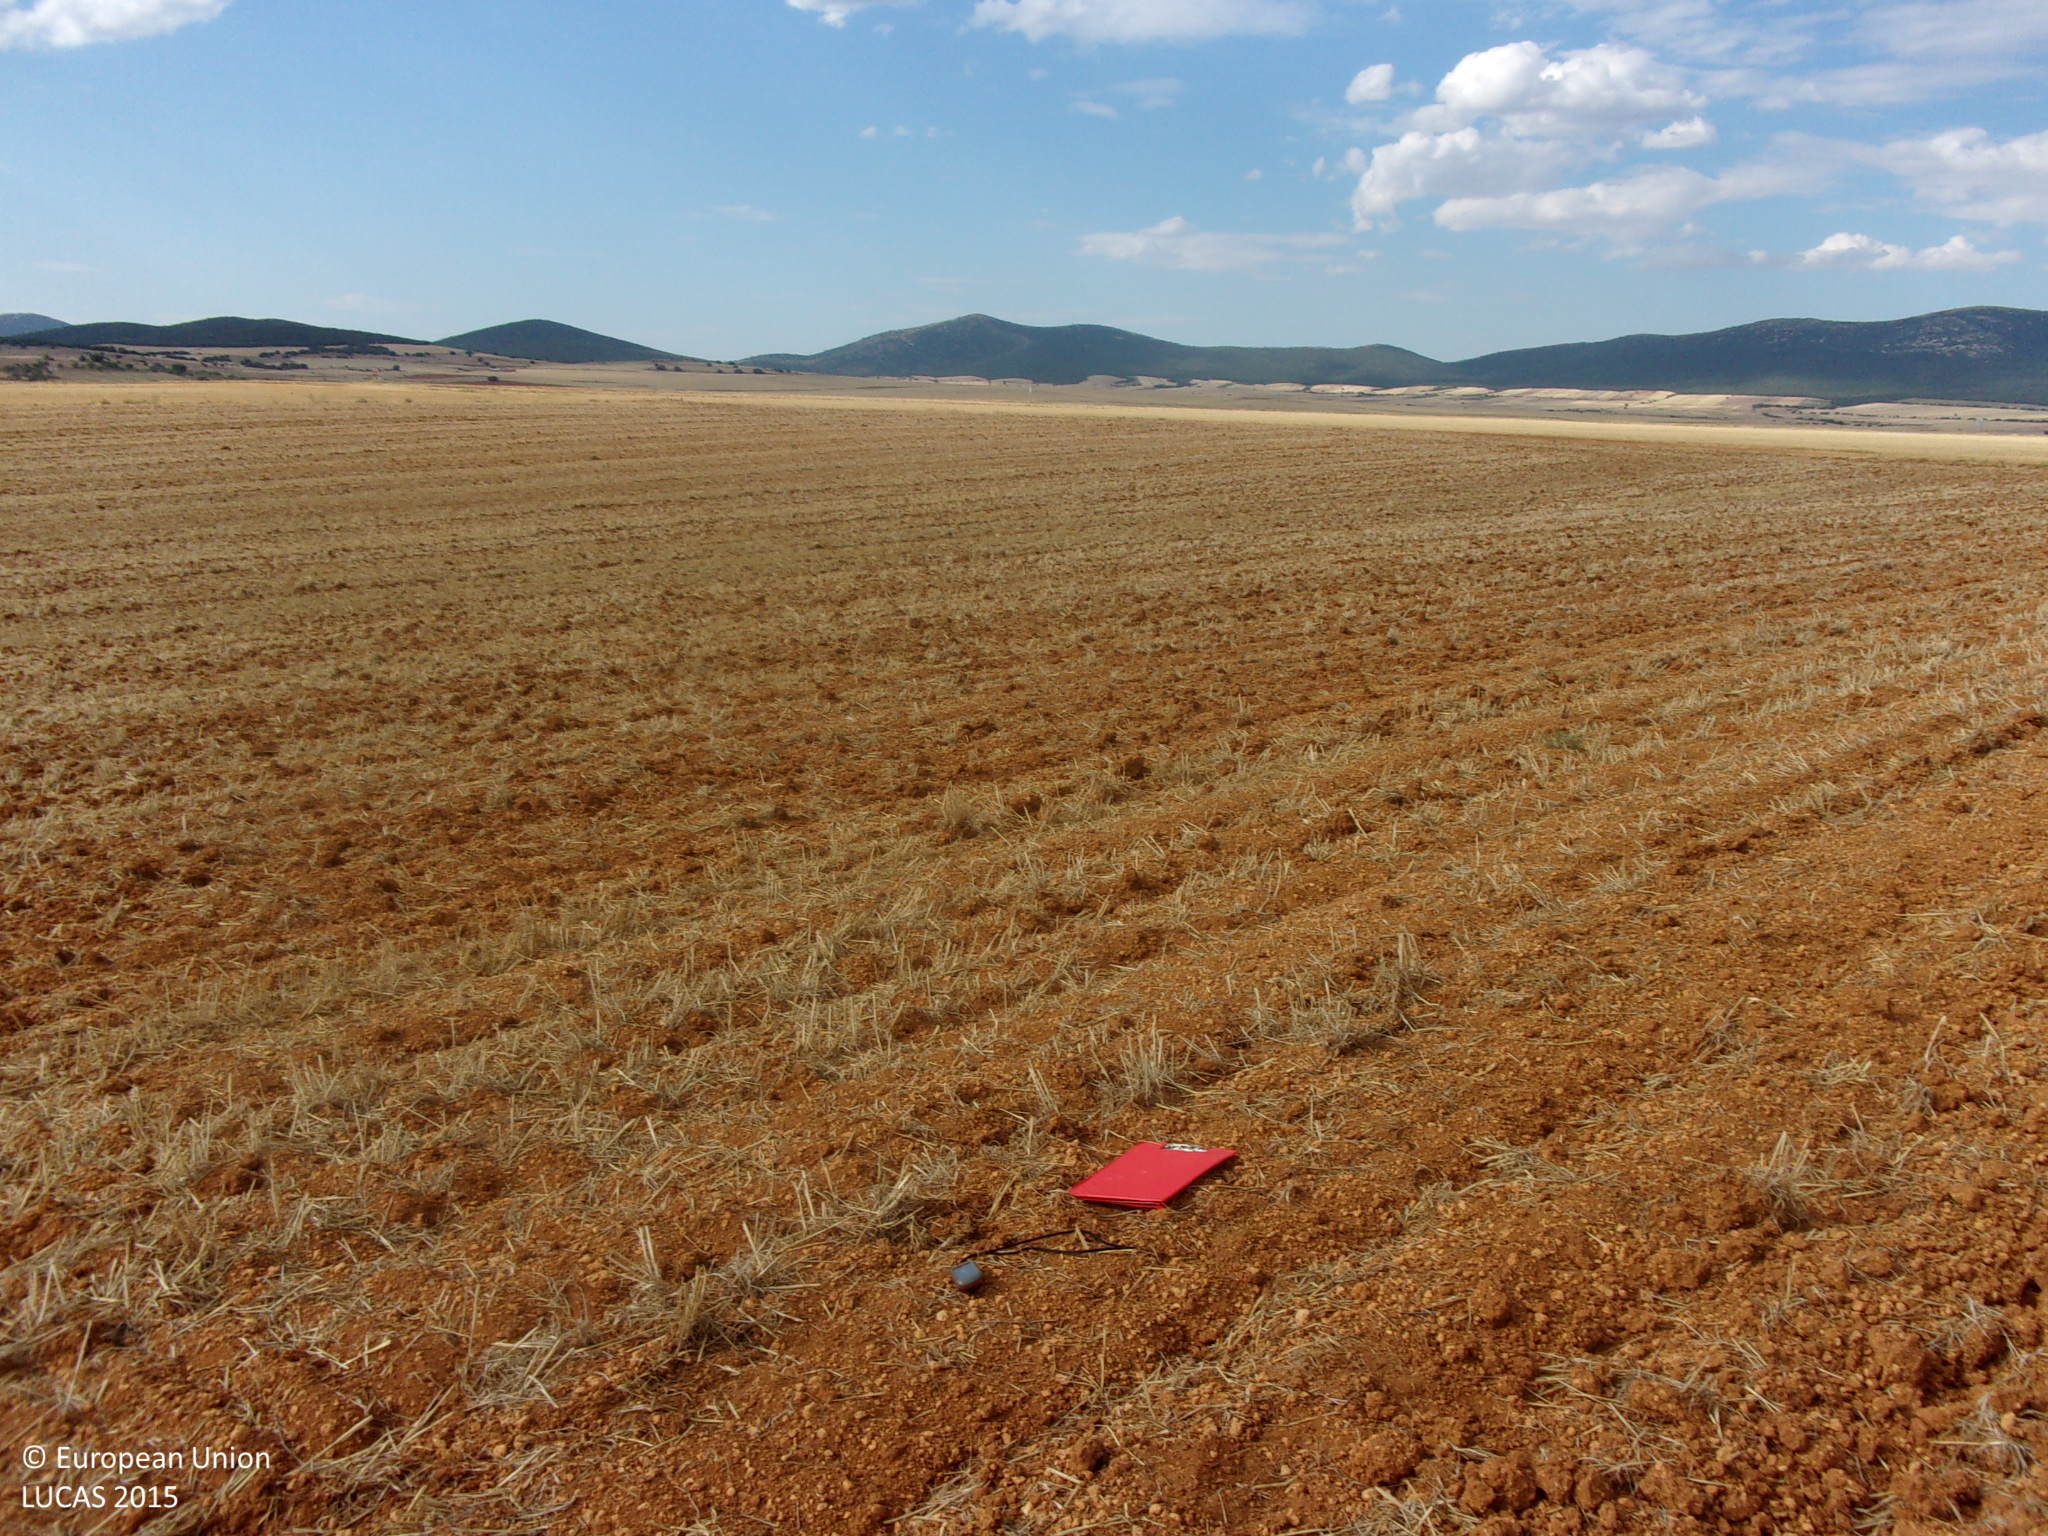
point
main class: Cropland
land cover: Barley
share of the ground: < 10 %
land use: Agriculture (excluding fallow land and kitchen gardens)
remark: Harvested field
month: July
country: ES
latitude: 41.2077
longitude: -1.3871
